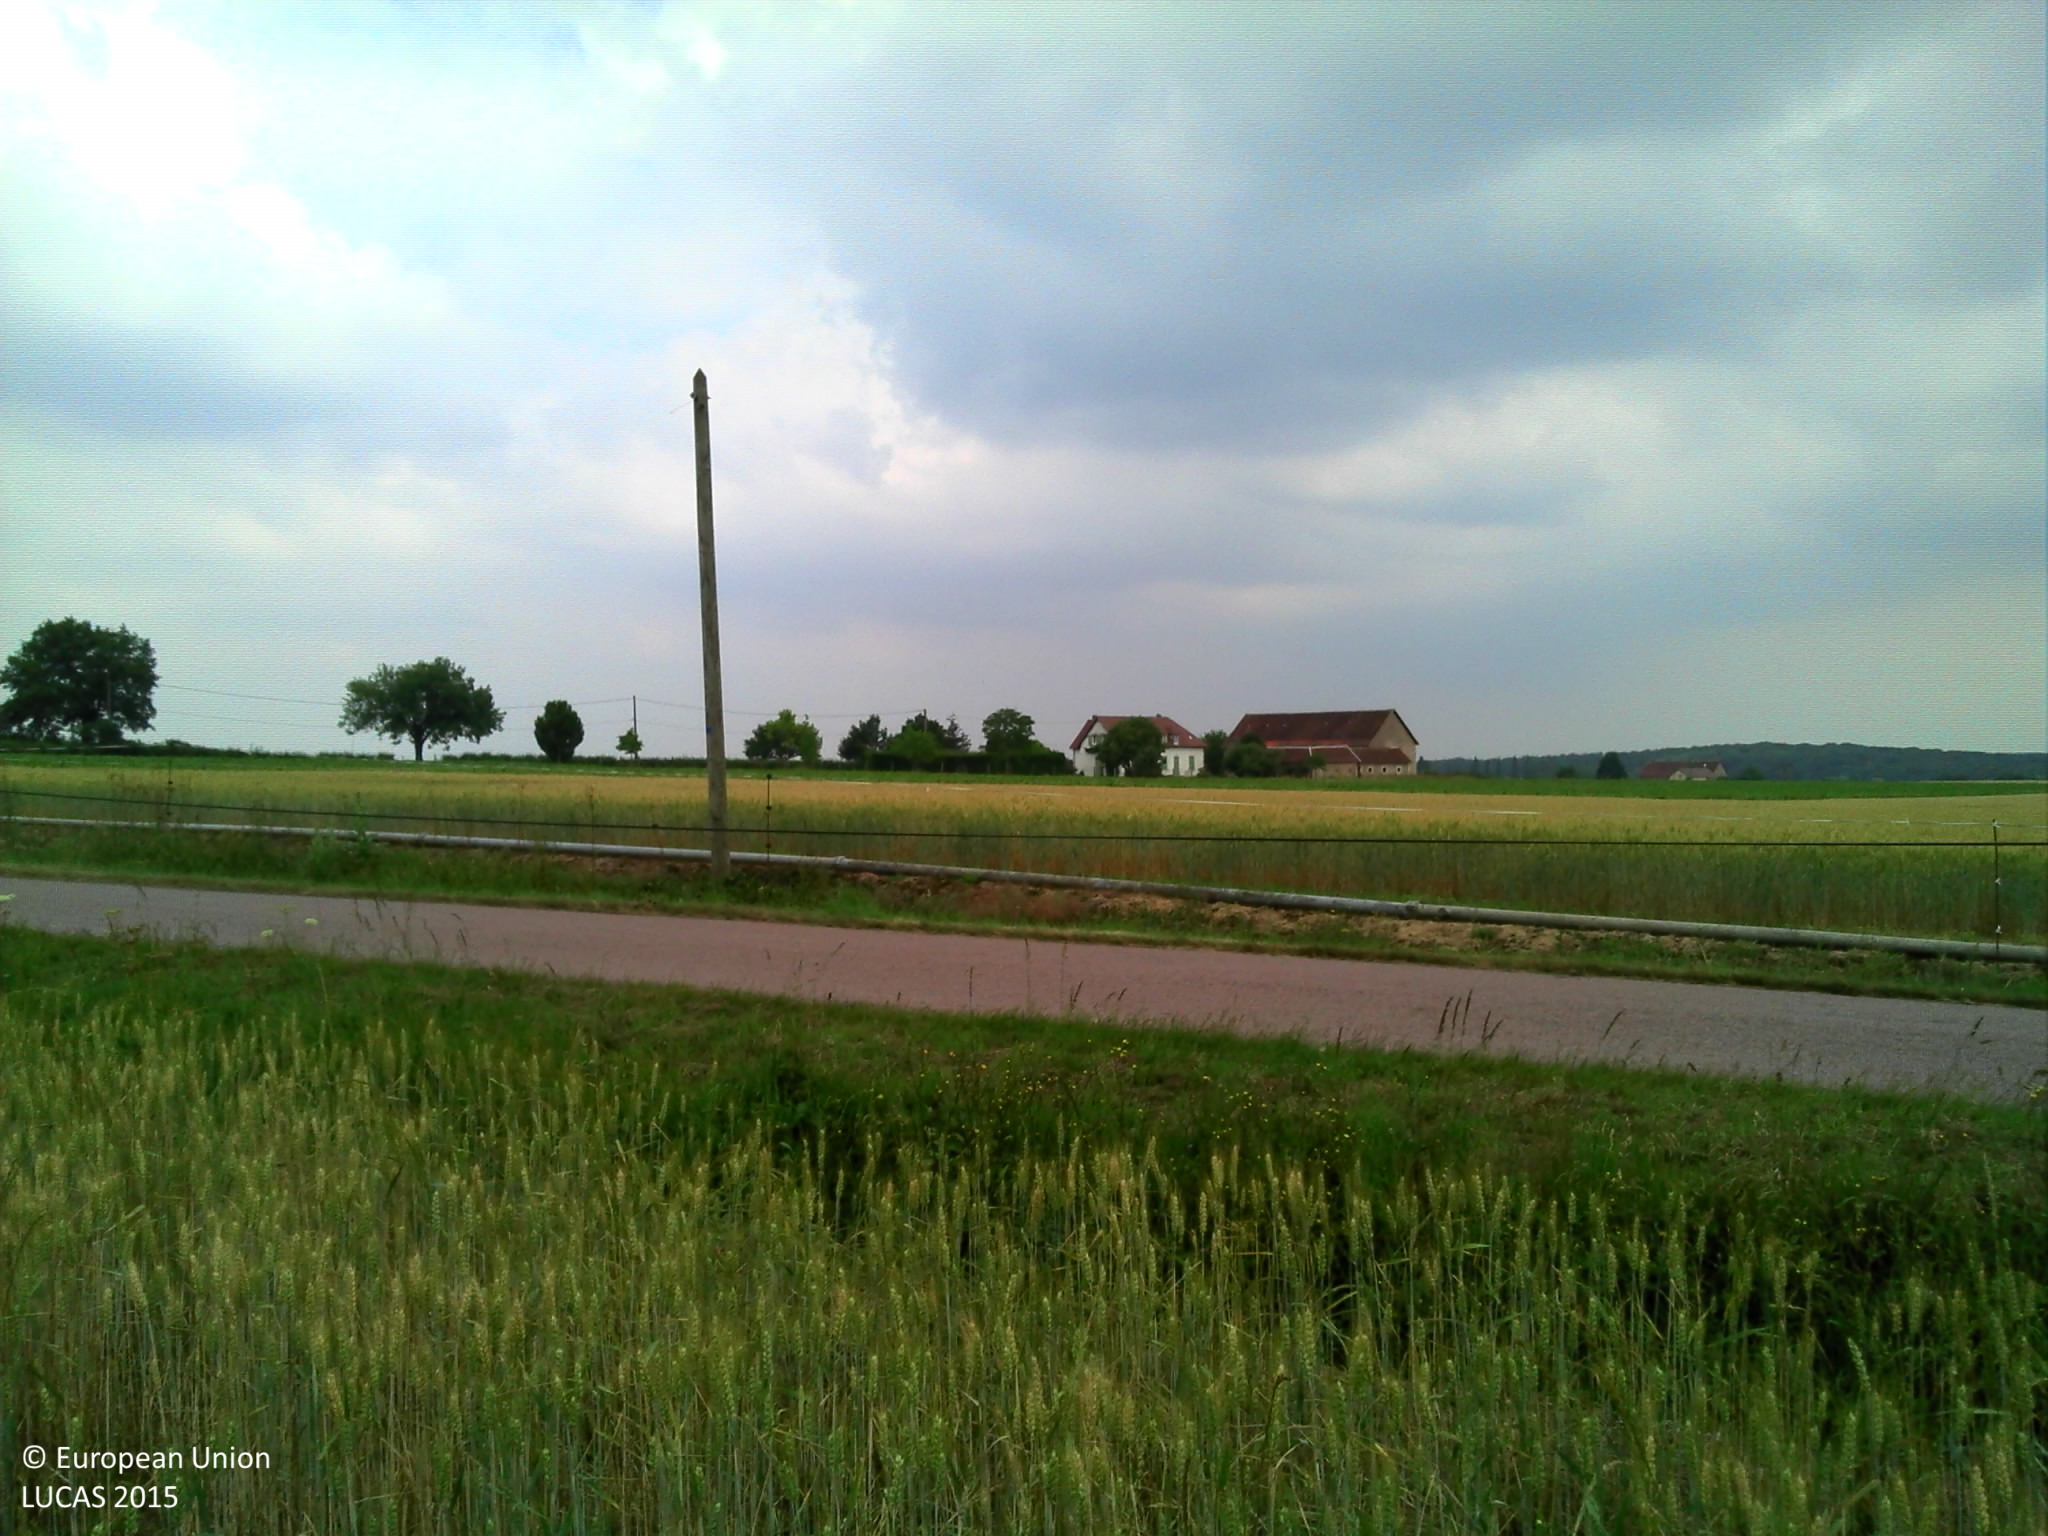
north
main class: Cropland
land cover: Common wheat
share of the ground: > 75 %
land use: Agriculture (excluding fallow land and kitchen gardens)
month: June
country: FR
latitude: 46.6077
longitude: 2.6973
